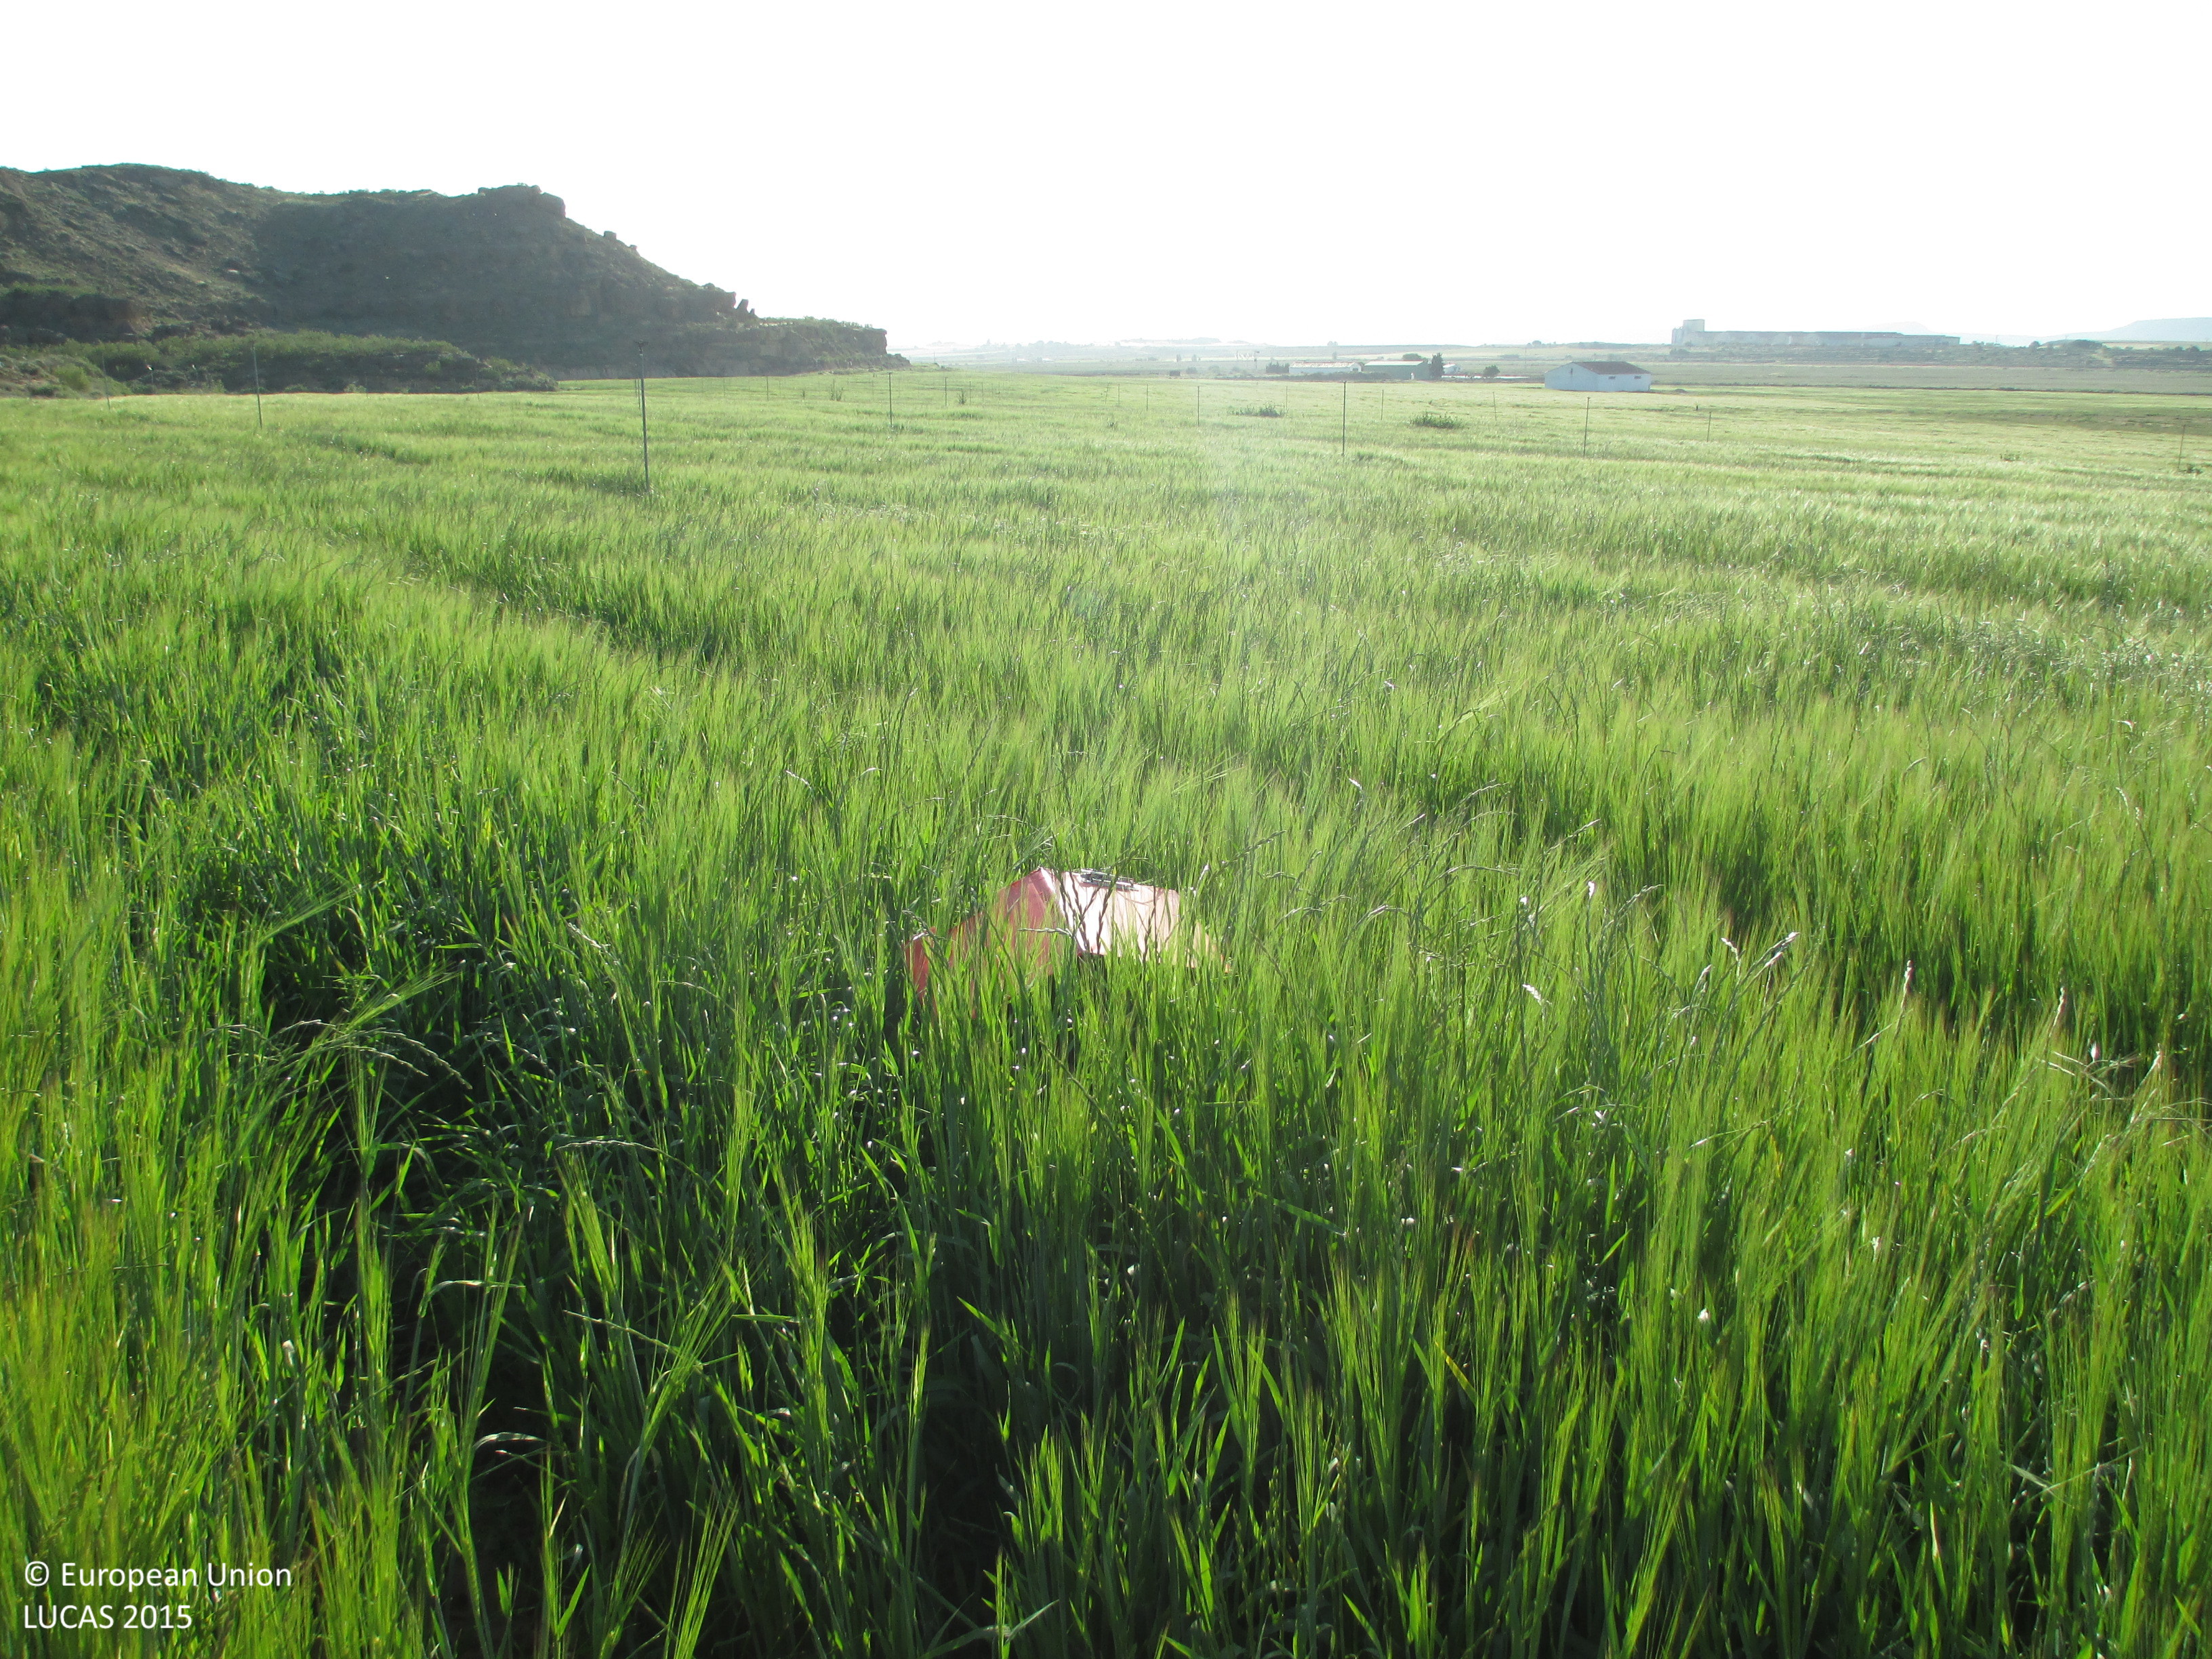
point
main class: Cropland
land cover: Barley
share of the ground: > 75 %
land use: Agriculture (excluding fallow land and kitchen gardens)
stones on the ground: < 10 %
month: May
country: ES
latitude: 41.9730
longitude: -0.3872
